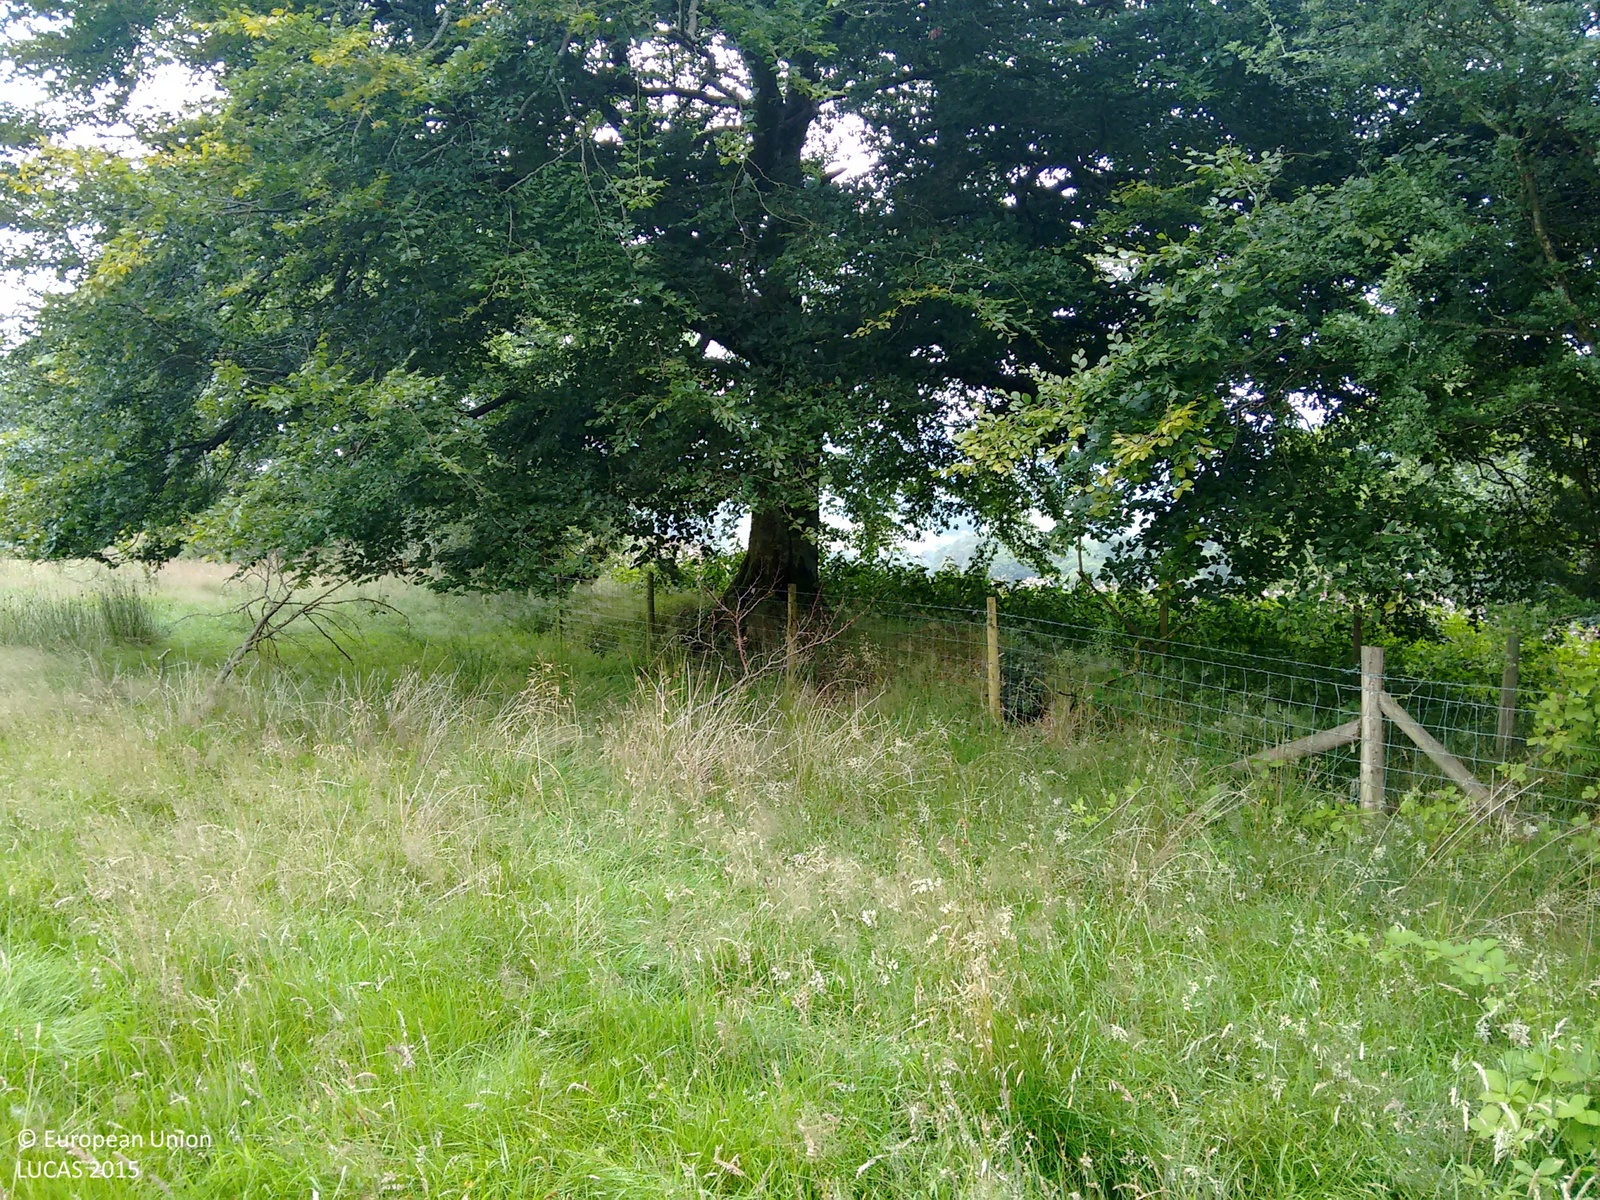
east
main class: Grassland
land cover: Grassland without tree/shrub cover
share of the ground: > 75 %
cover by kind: herbaceous plants 100 %
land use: Agriculture (excluding fallow land and kitchen gardens)
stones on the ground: < 10 %
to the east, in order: Grassland without tree/shrub cover; Fences; Single bushes/trees; Shruby margins; Fences; Grassland without tree/shrub cover; Fences; Abandoned hedges; Ditches and canals; Fences; Grassland without tree/shrub cover; Ditches and canals; Grassland without tree/shrub cover; Shrubland without tree cover; Broadleaved woodland
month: August
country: GB
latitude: 52.0085
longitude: -3.9185
